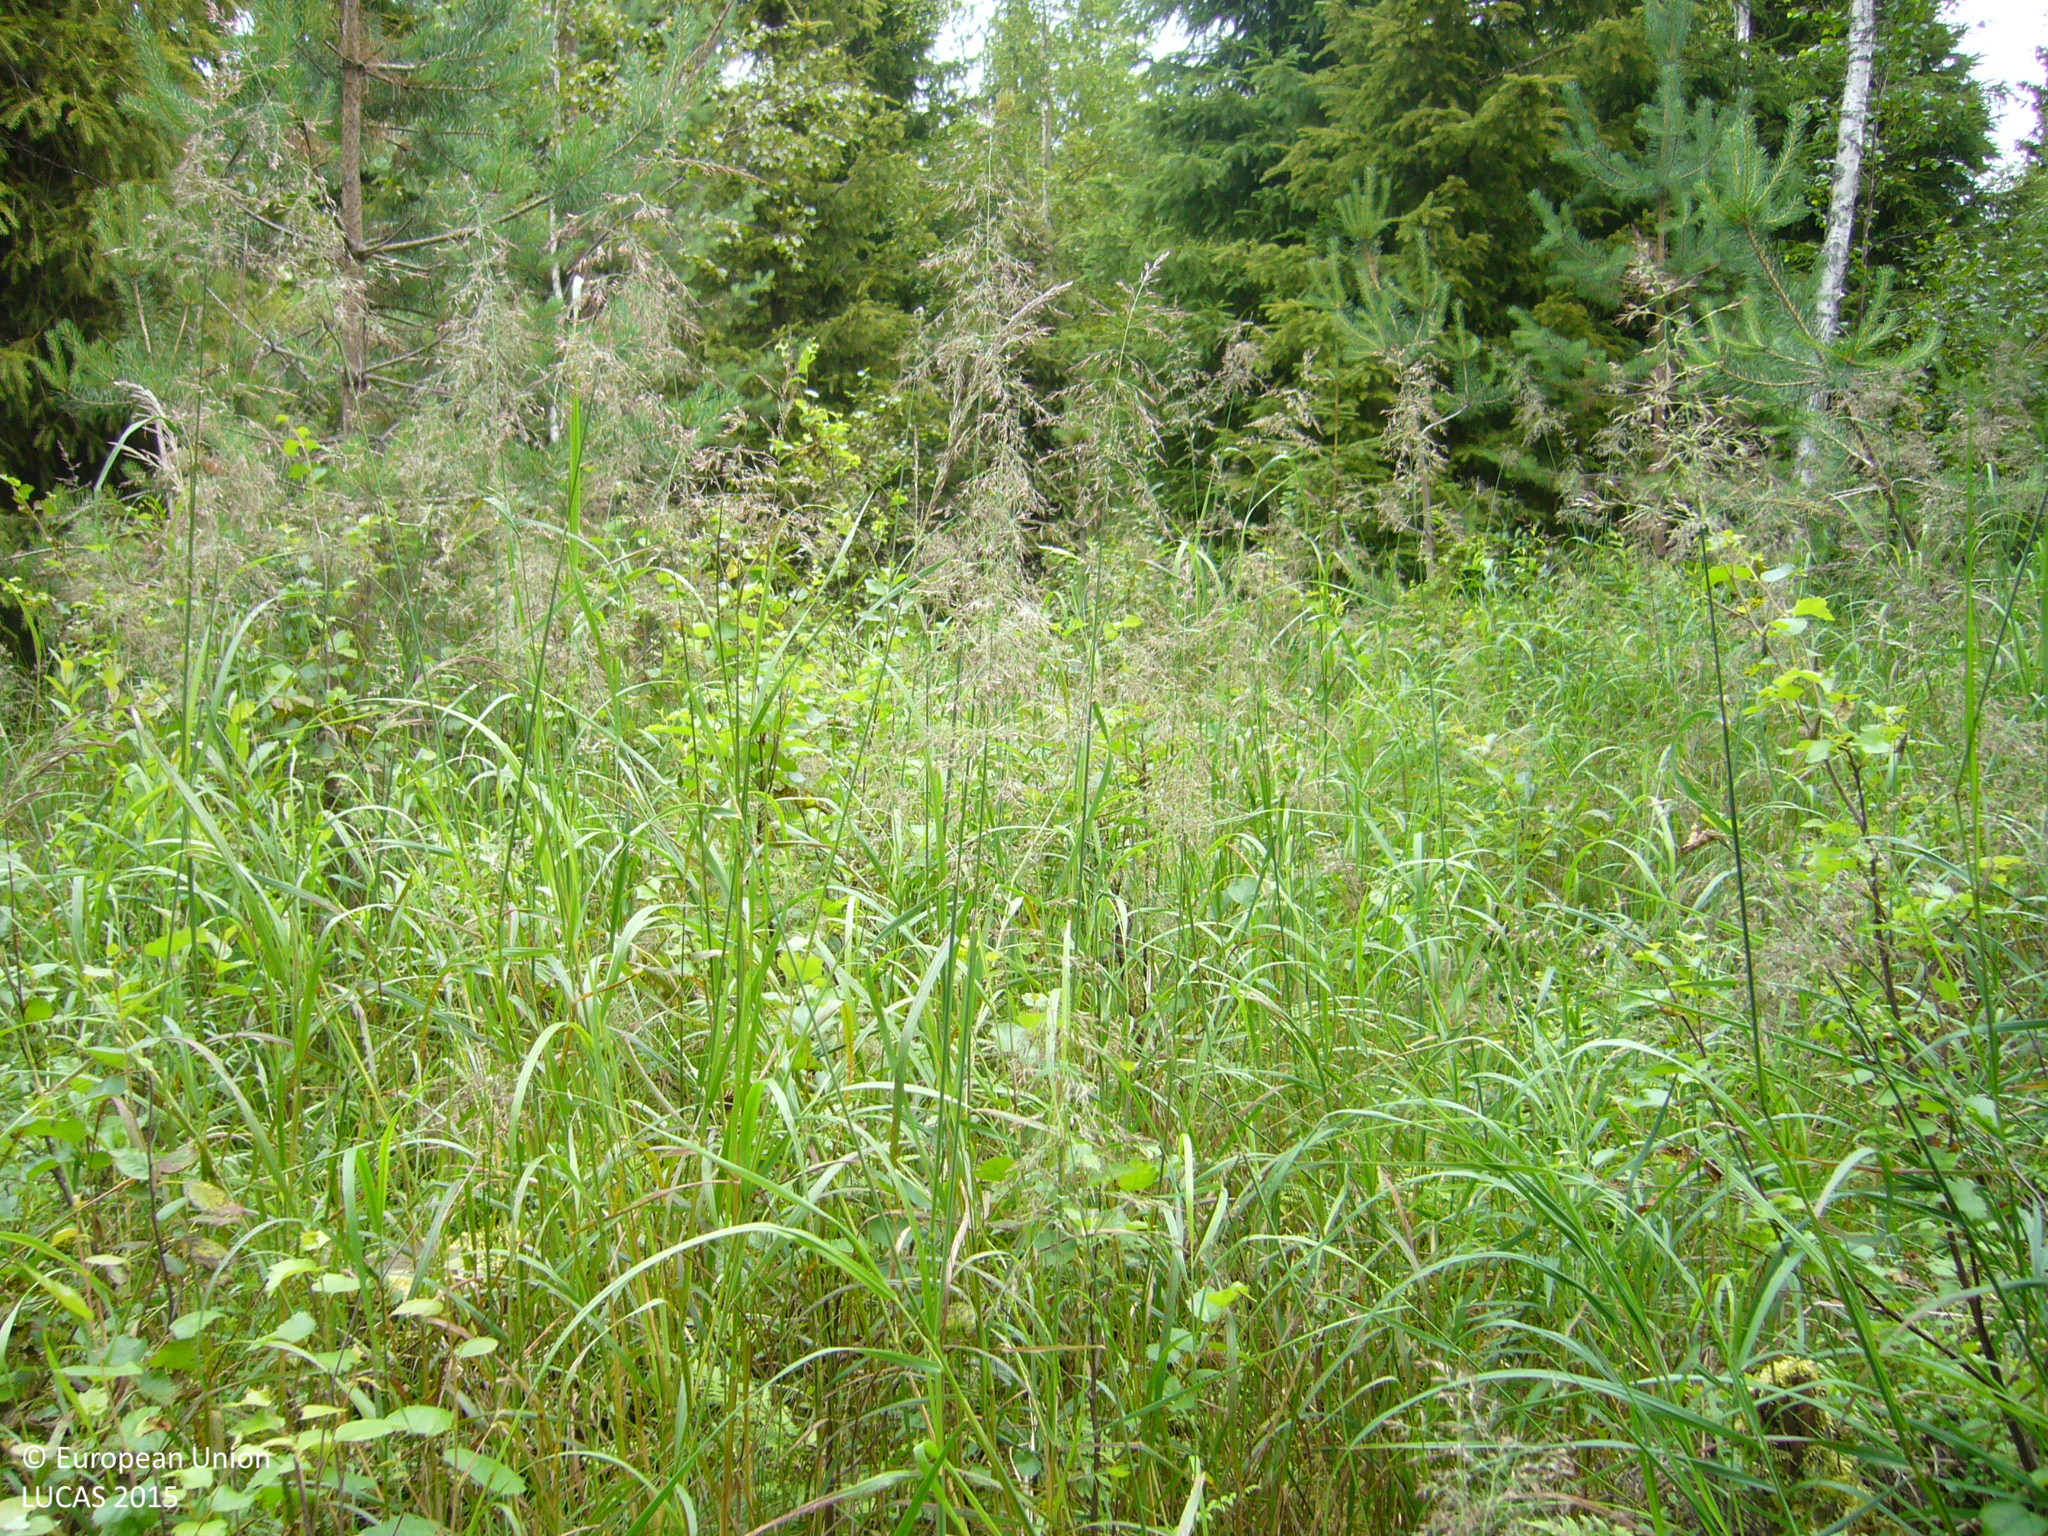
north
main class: Woodland
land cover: Spruce dominated mixed woodland
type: boreal forest
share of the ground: 50 - 75 %
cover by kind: coniferous forest trees 40 %, broadleaved forest trees 30 %, shrubs 30 %
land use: Forestry
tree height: > 5 m
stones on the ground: < 10 %
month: July
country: FI
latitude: 64.1391
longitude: 25.9474
